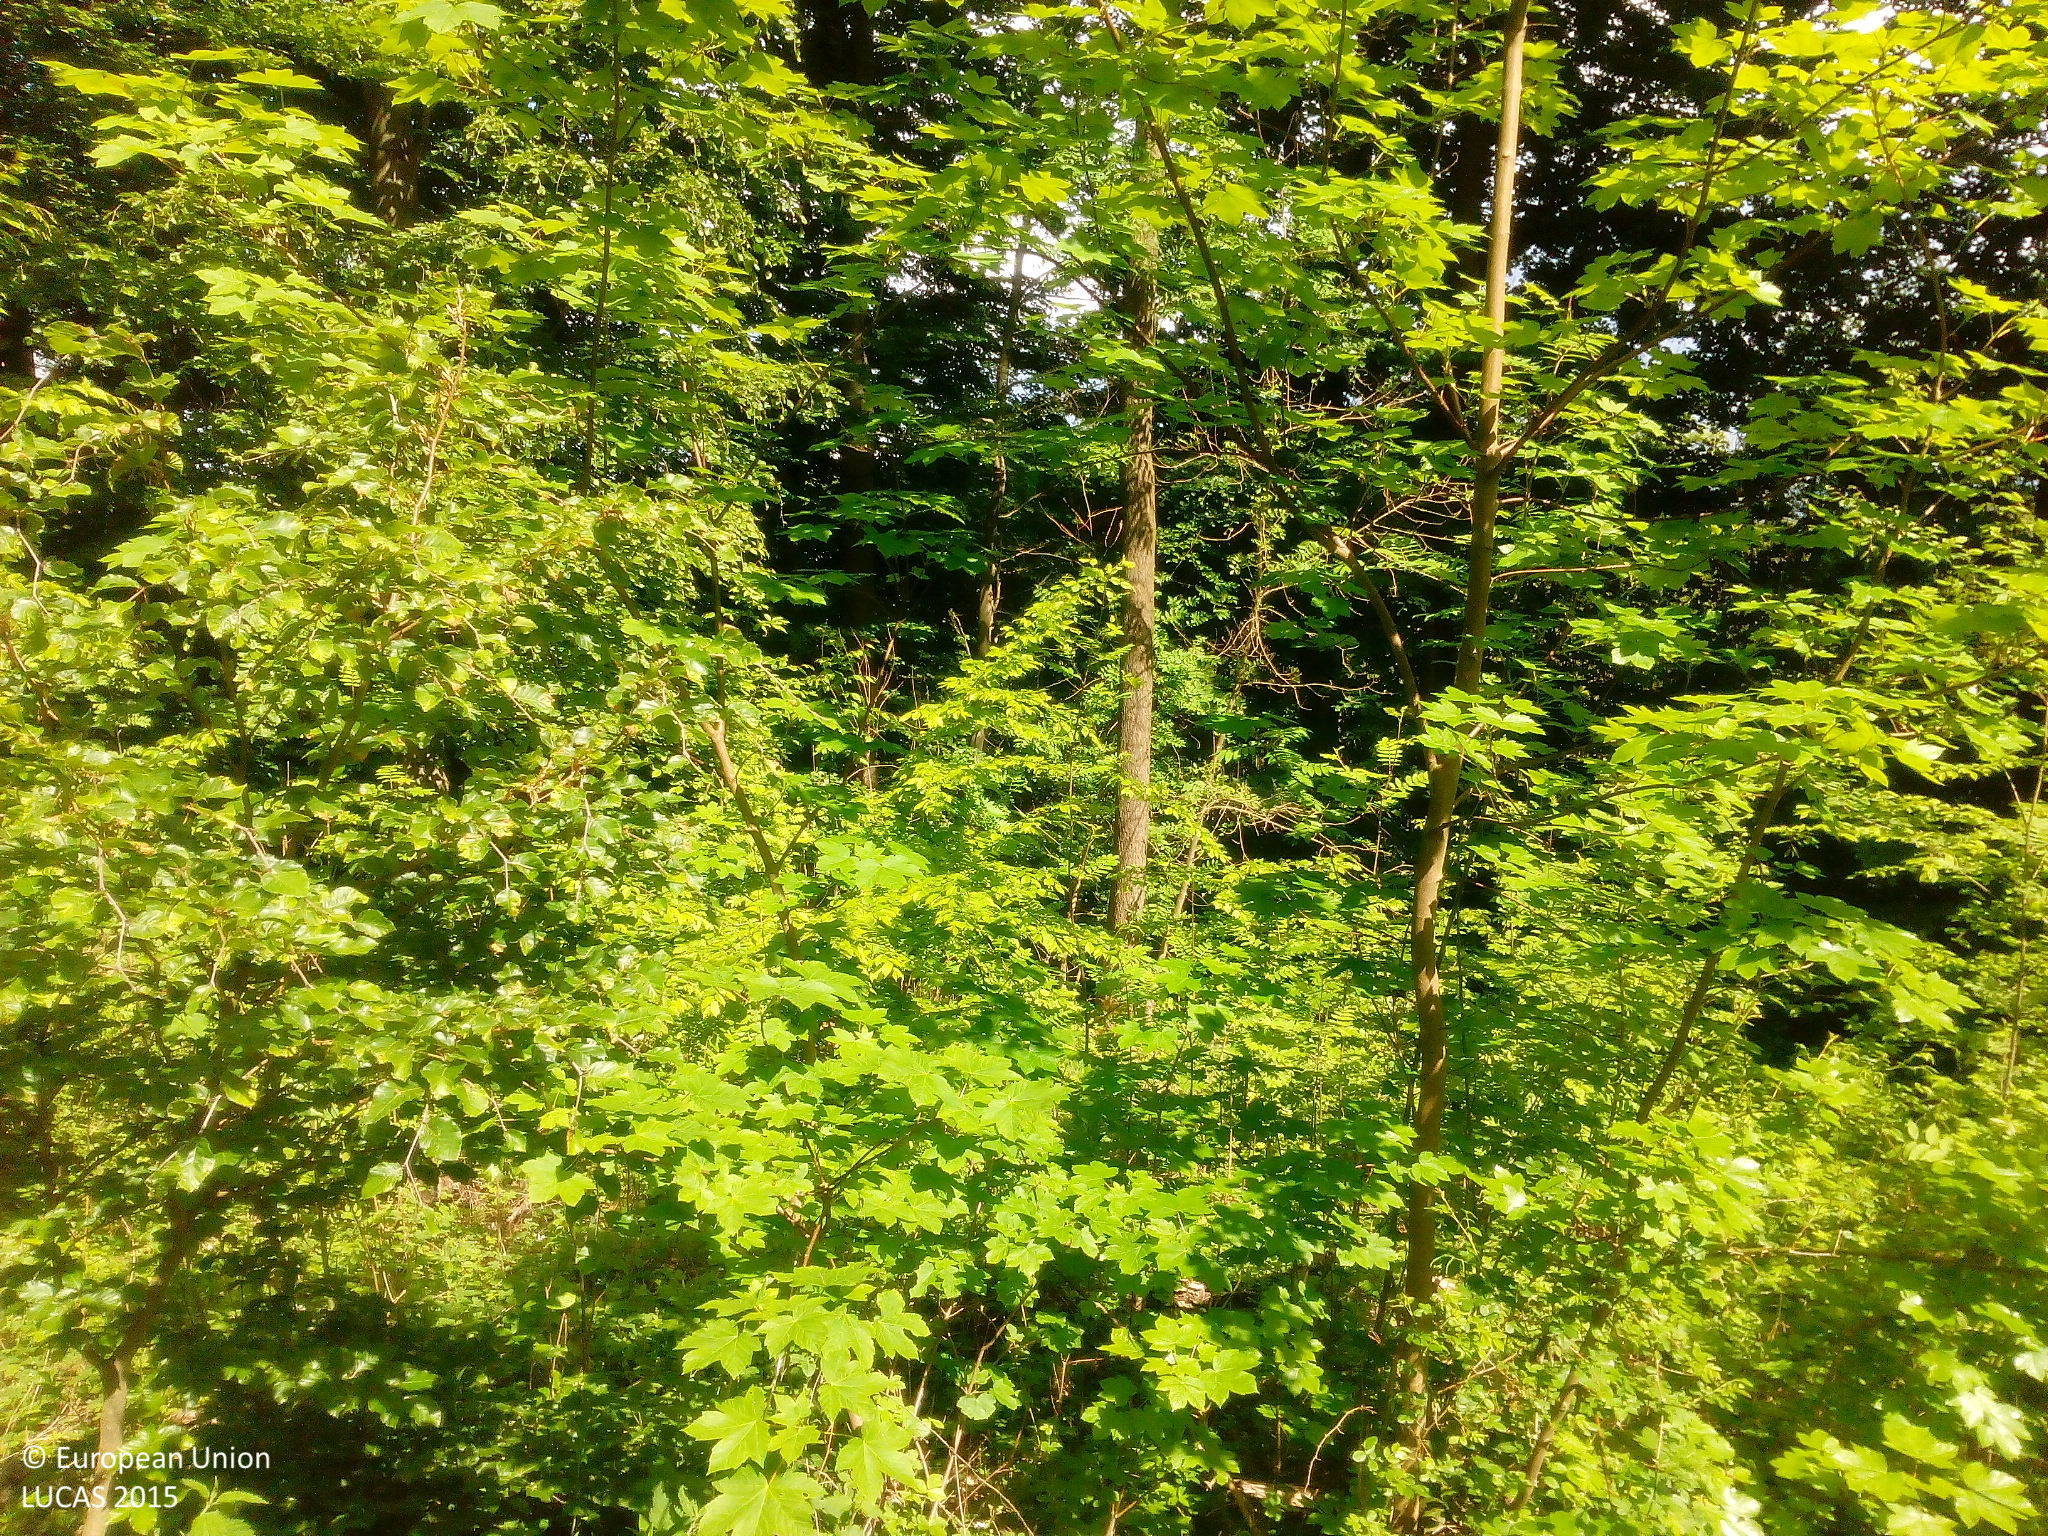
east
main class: Woodland
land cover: Broadleaved woodland
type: beech forest
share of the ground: > 75 %
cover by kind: broadleaved forest trees 100 %
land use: Forestry
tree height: > 5 m
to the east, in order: Broadleaved woodland; Fences; Grass margins; Paved roads, cycling and walking lanes; Grassland without tree/shrub cover; Grassland with sparse tree/shrub cover; Grassland without tree/shrub cover; Broadleaved woodland
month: May
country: DE
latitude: 51.3511
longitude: 9.3541
